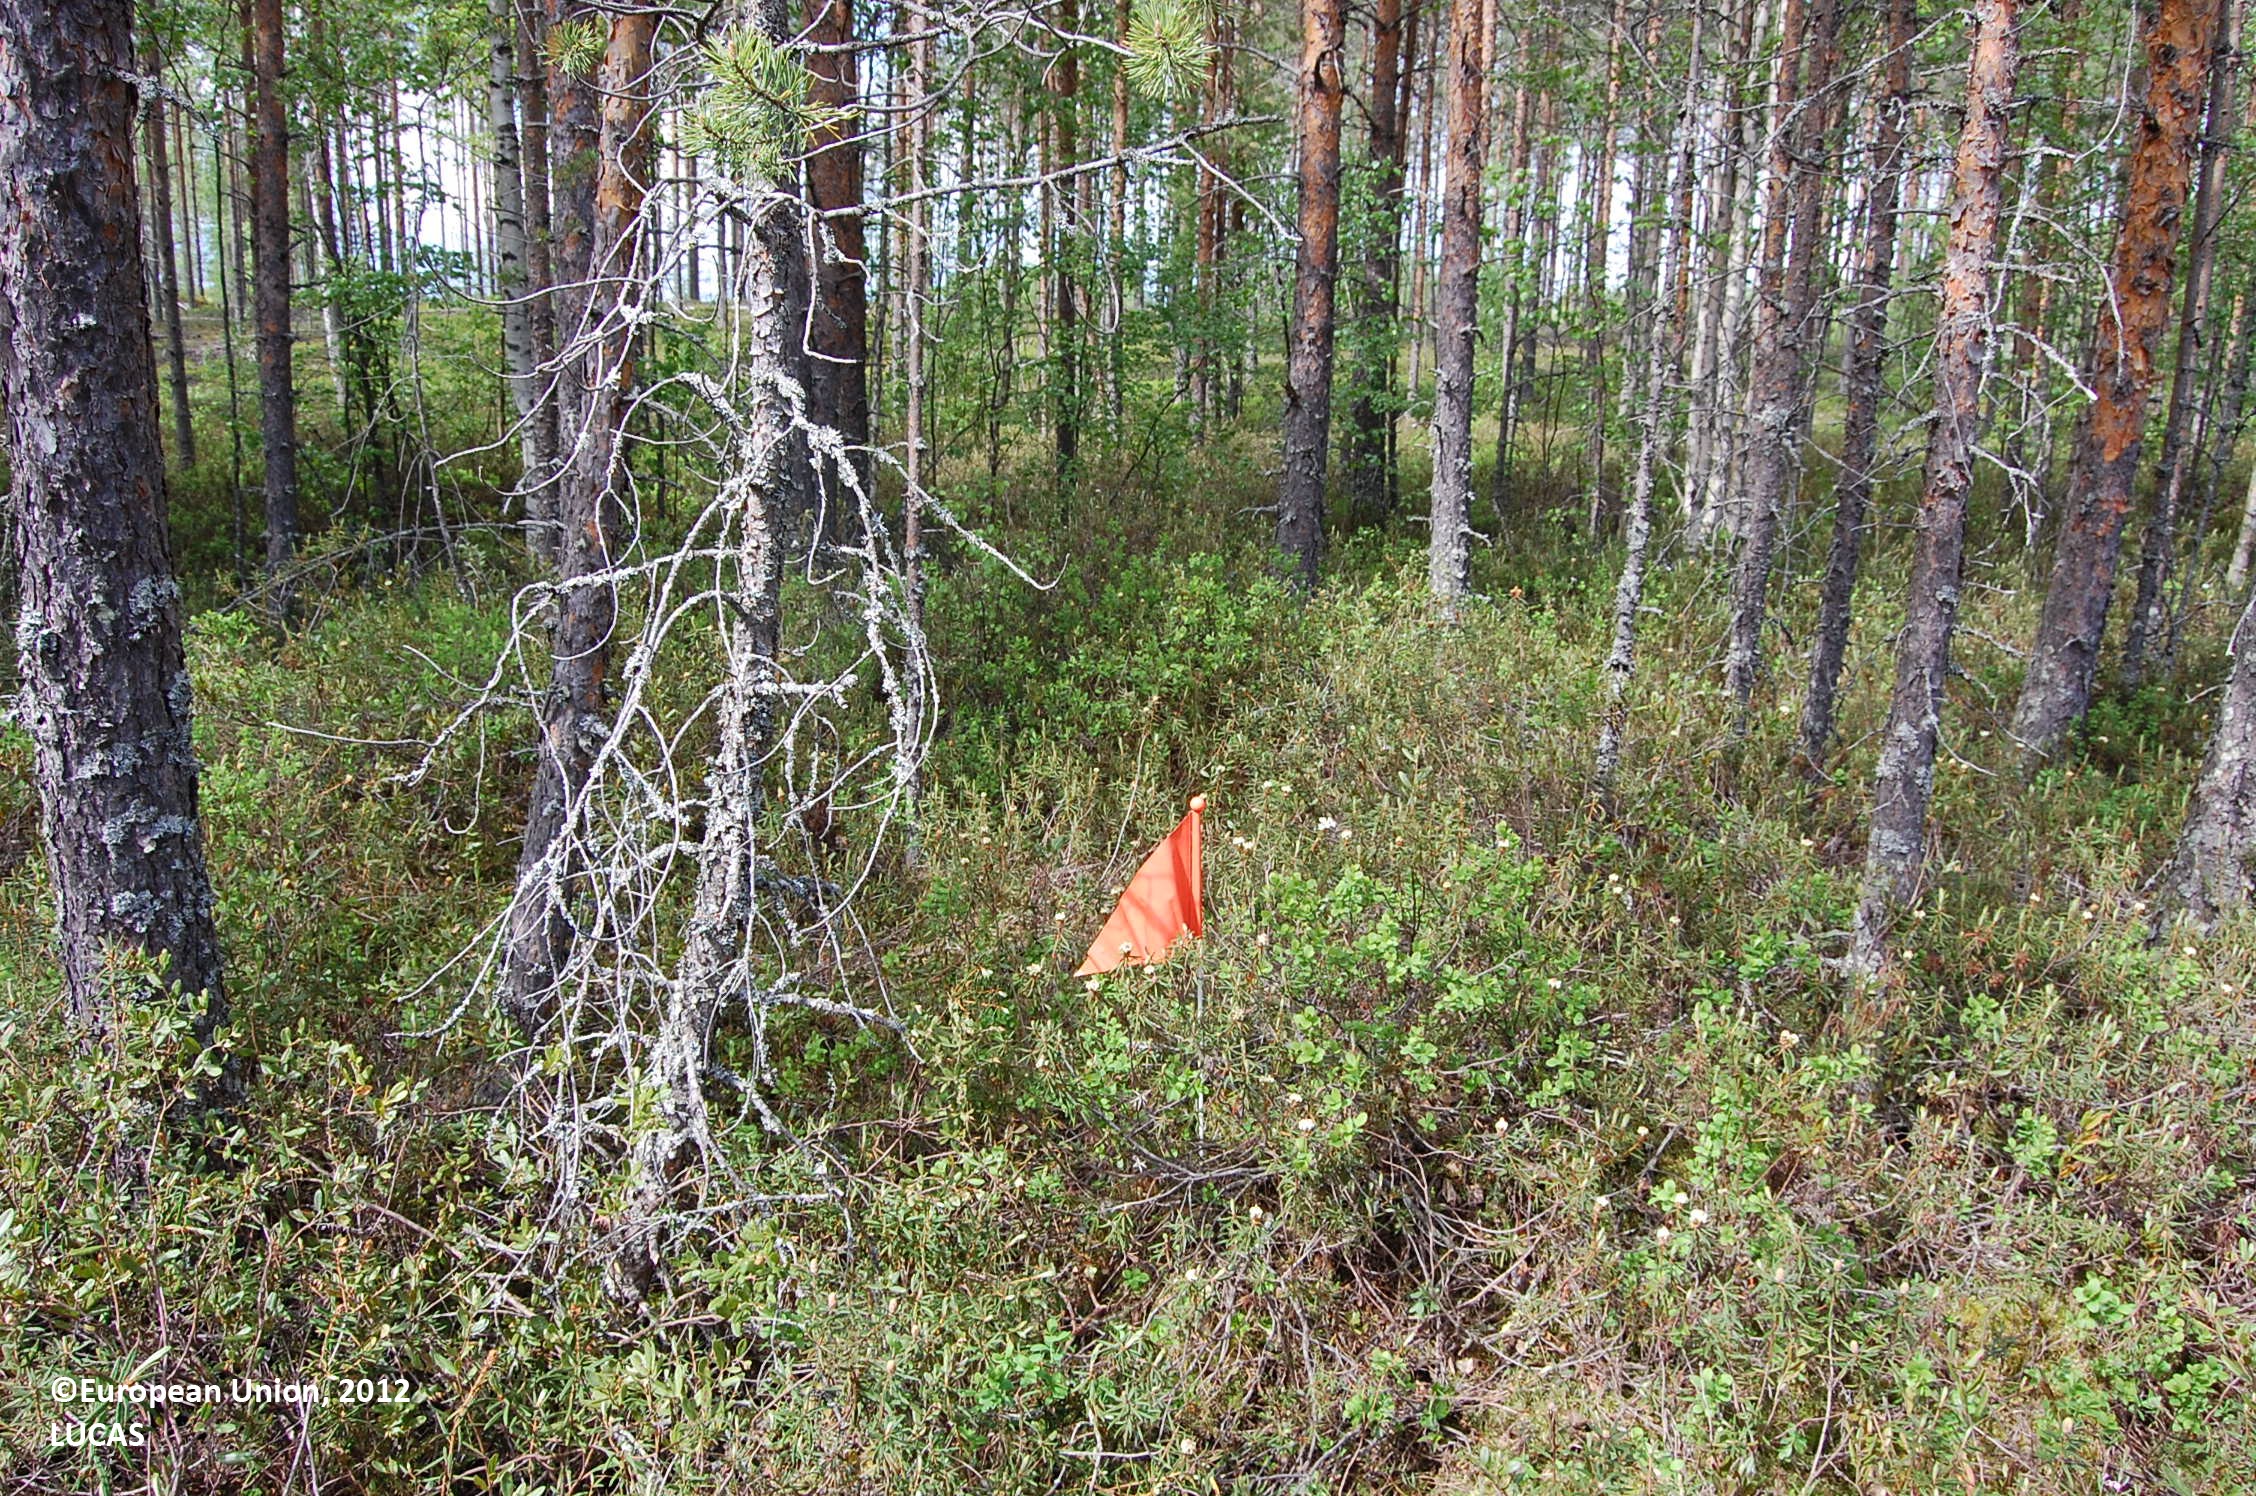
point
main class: Woodland
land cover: Pine dominated coniferous woodland
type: hemiboreal forest and nemoral coniferous forest and mixed broadleaved-coniferous forest
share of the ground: > 75 %
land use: Forestry
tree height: > 5 m
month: June
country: FI
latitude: 64.1278
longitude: 26.2358
